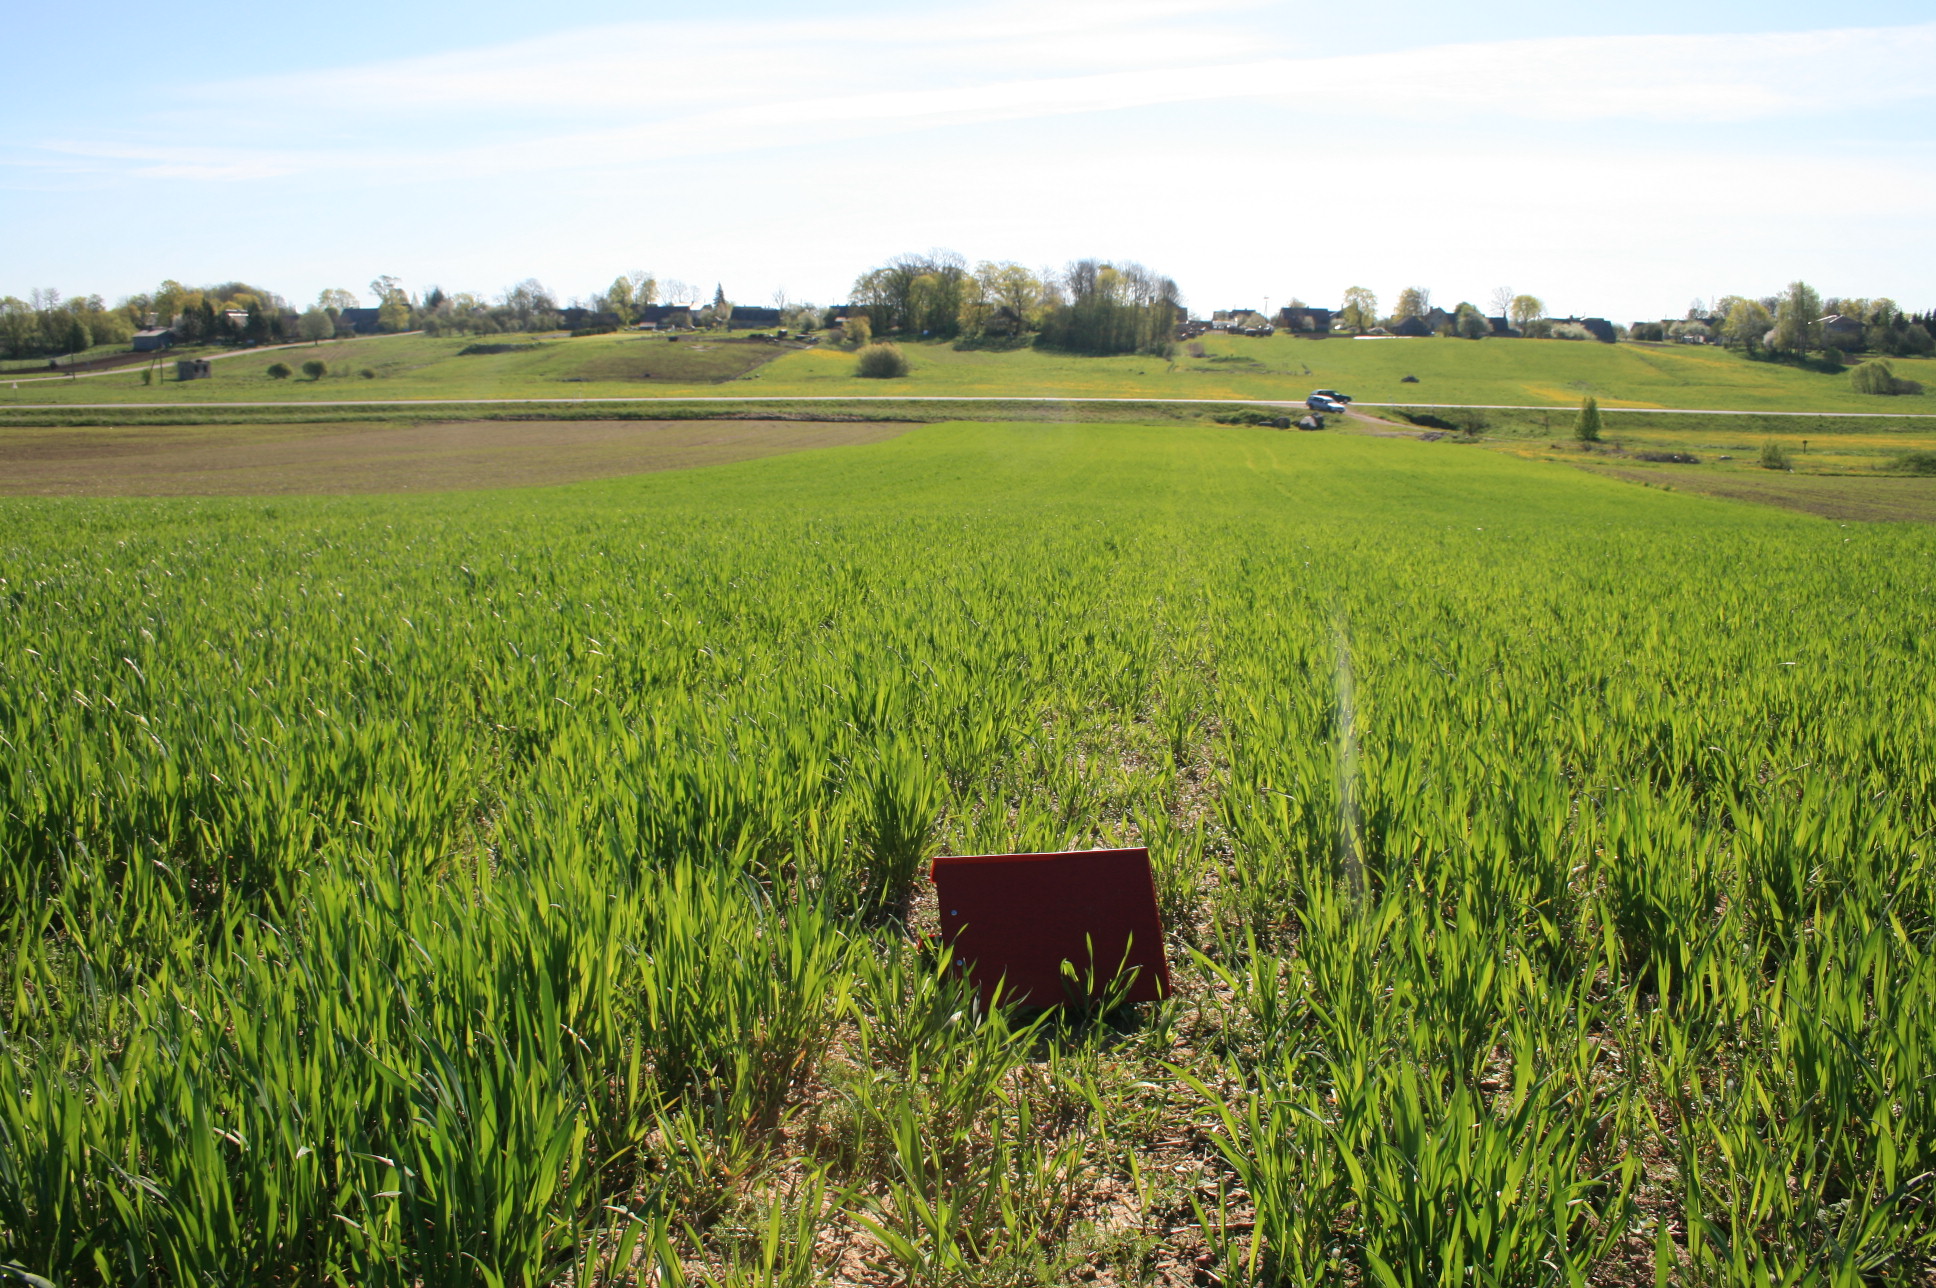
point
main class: Cropland
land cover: Barley
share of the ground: > 75 %
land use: Agriculture (excluding fallow land and kitchen gardens)
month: May
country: LT
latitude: 56.0810
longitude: 21.5658
